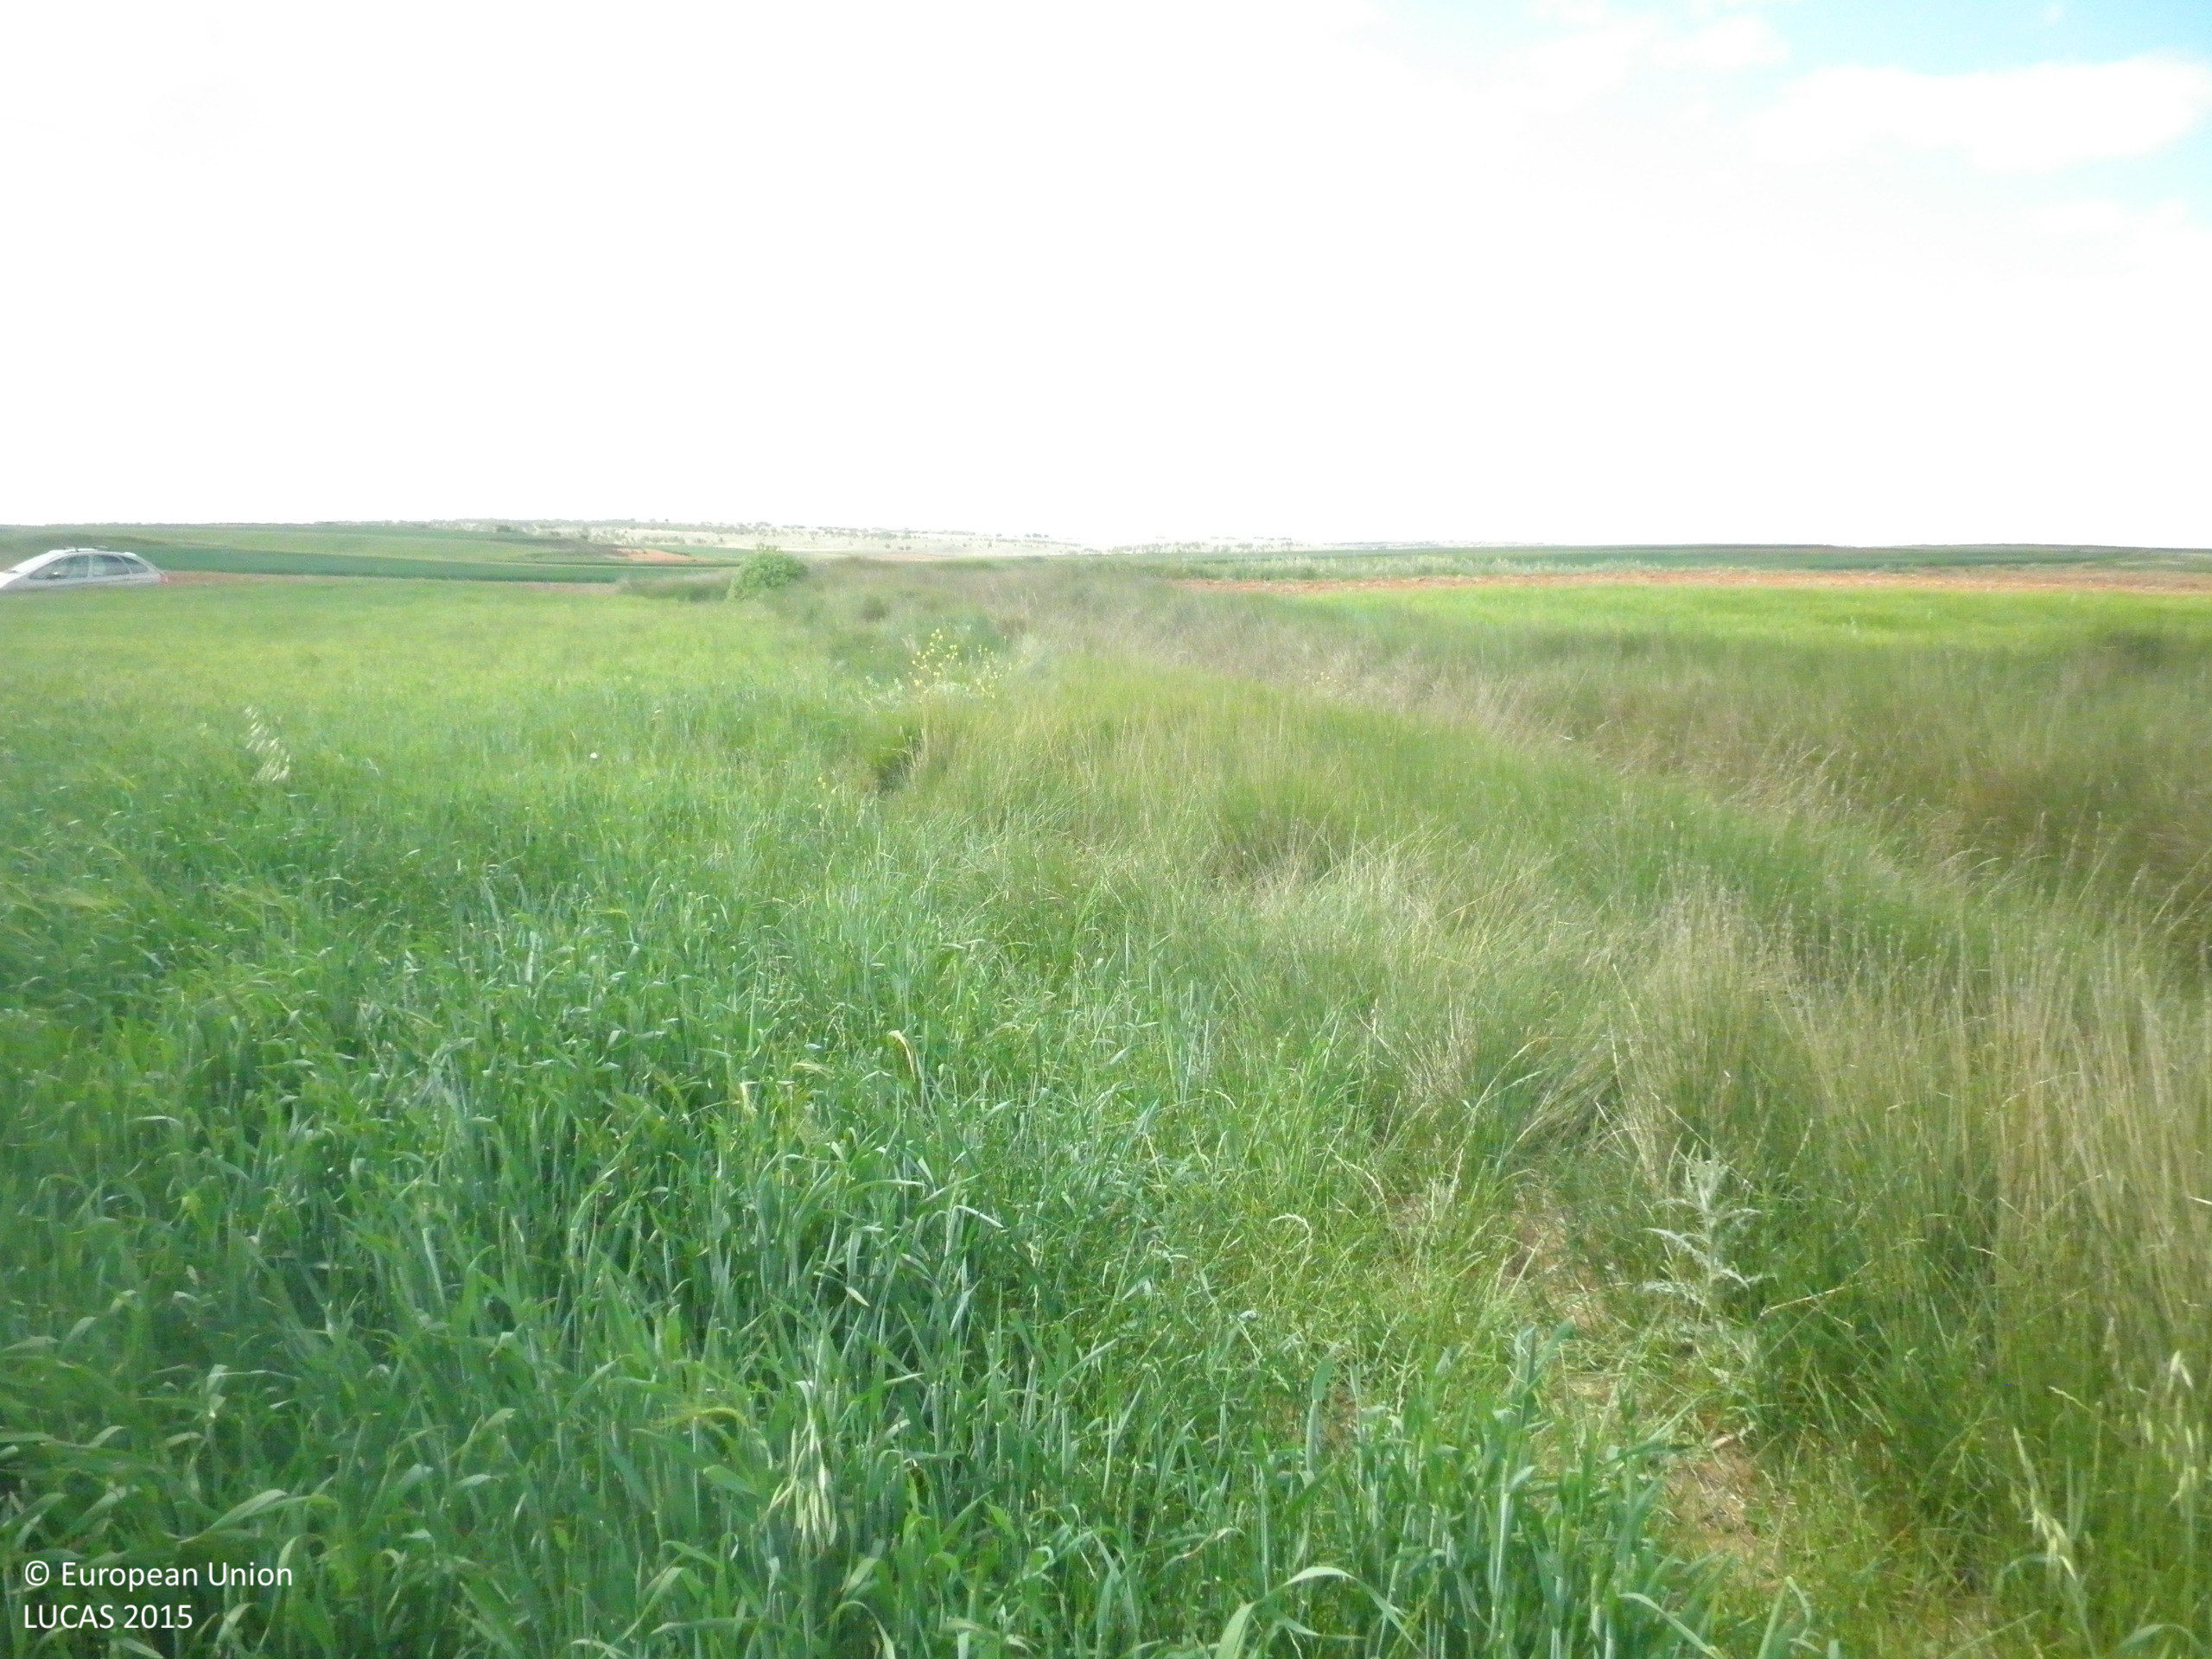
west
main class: Cropland
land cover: Barley
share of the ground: > 75 %
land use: Agriculture (excluding fallow land and kitchen gardens)
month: May
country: ES
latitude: 39.7159
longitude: -2.8146
